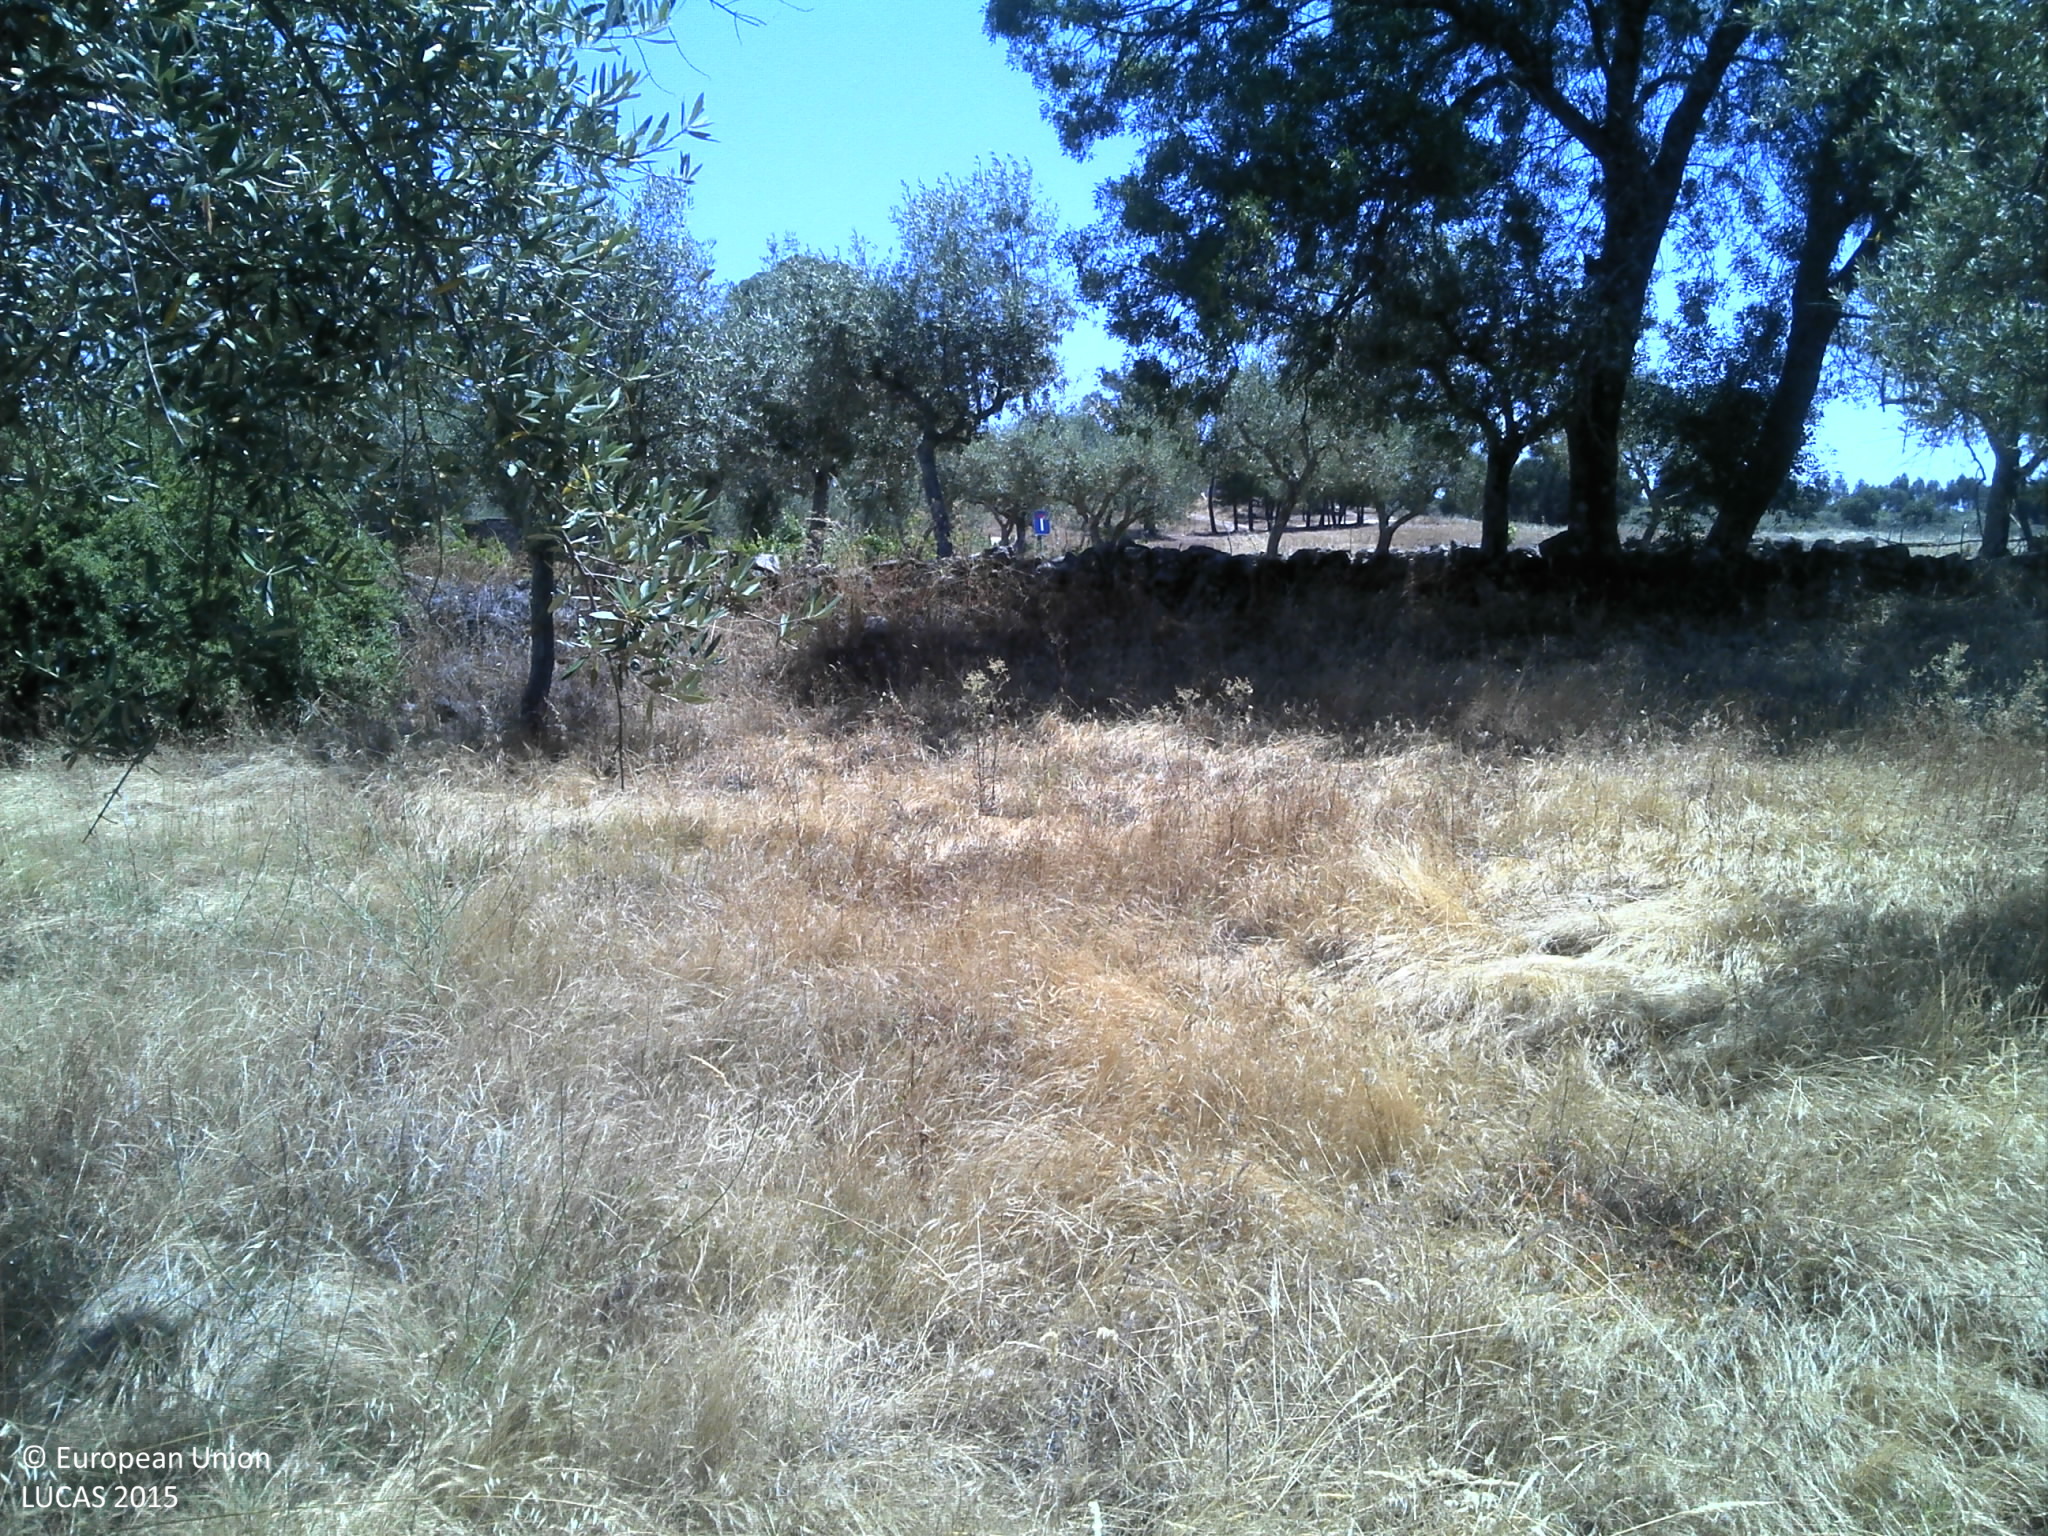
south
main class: Cropland
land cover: Olive groves
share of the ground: 25 - 50 %
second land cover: Grassland without tree/shrub cover
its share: 50 - 75 %
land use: Agriculture (excluding fallow land and kitchen gardens)
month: June
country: PT
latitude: 39.9168
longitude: -7.4014
